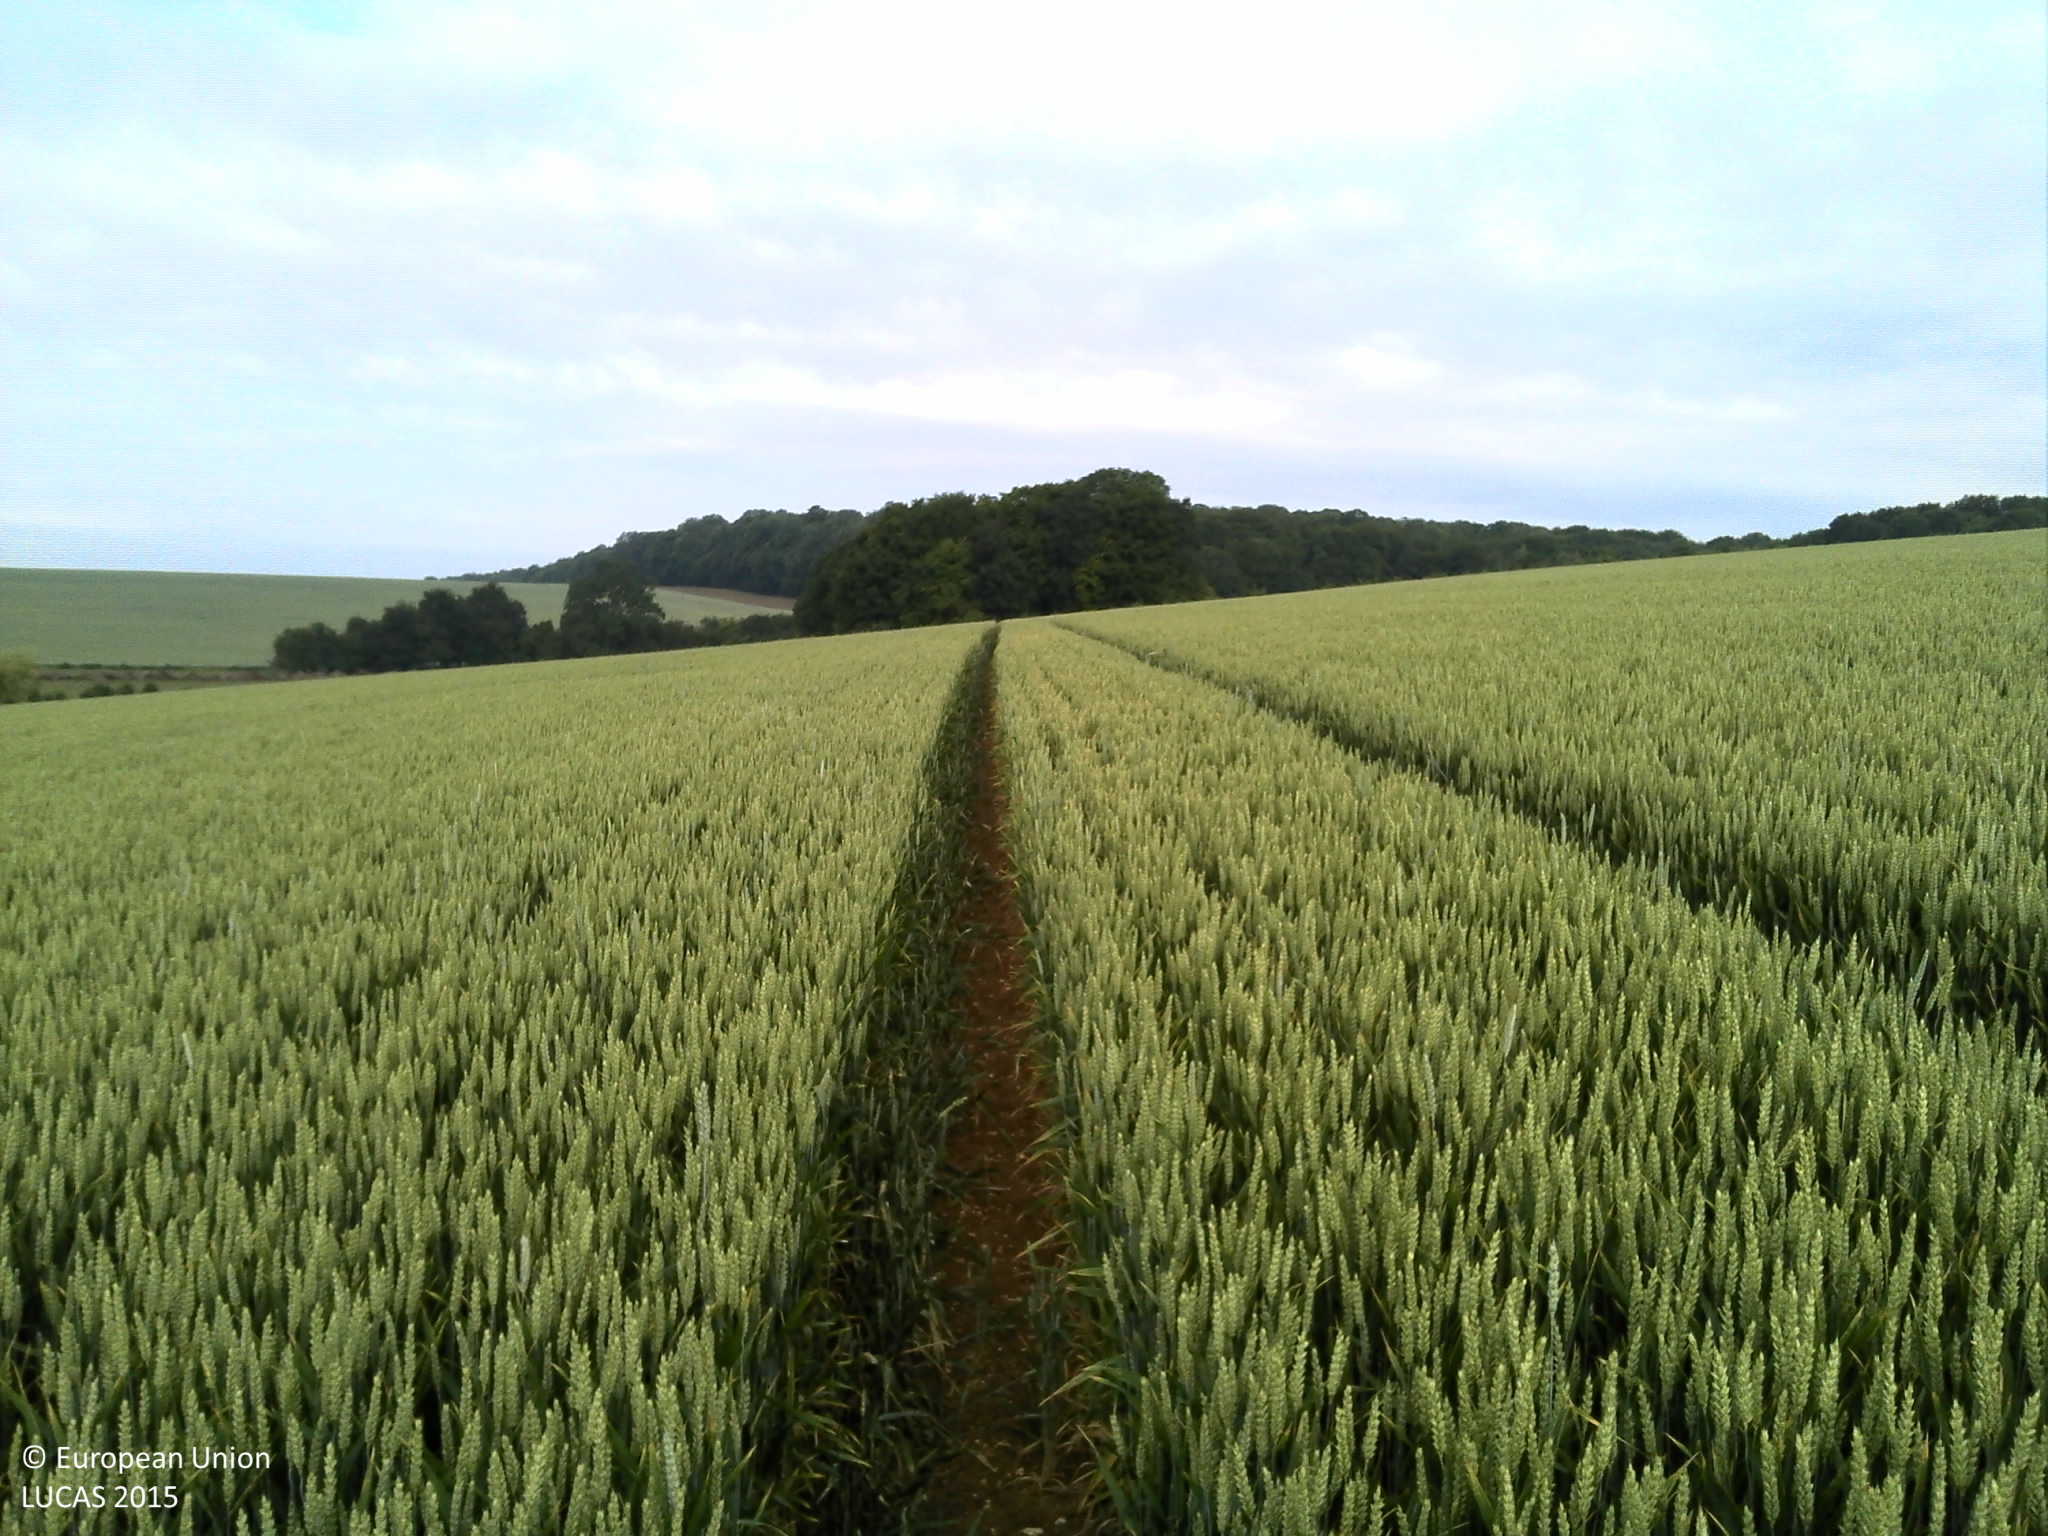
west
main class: Cropland
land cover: Common wheat
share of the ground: > 75 %
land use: Agriculture (excluding fallow land and kitchen gardens)
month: June
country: FR
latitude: 49.3754
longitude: 5.0808
